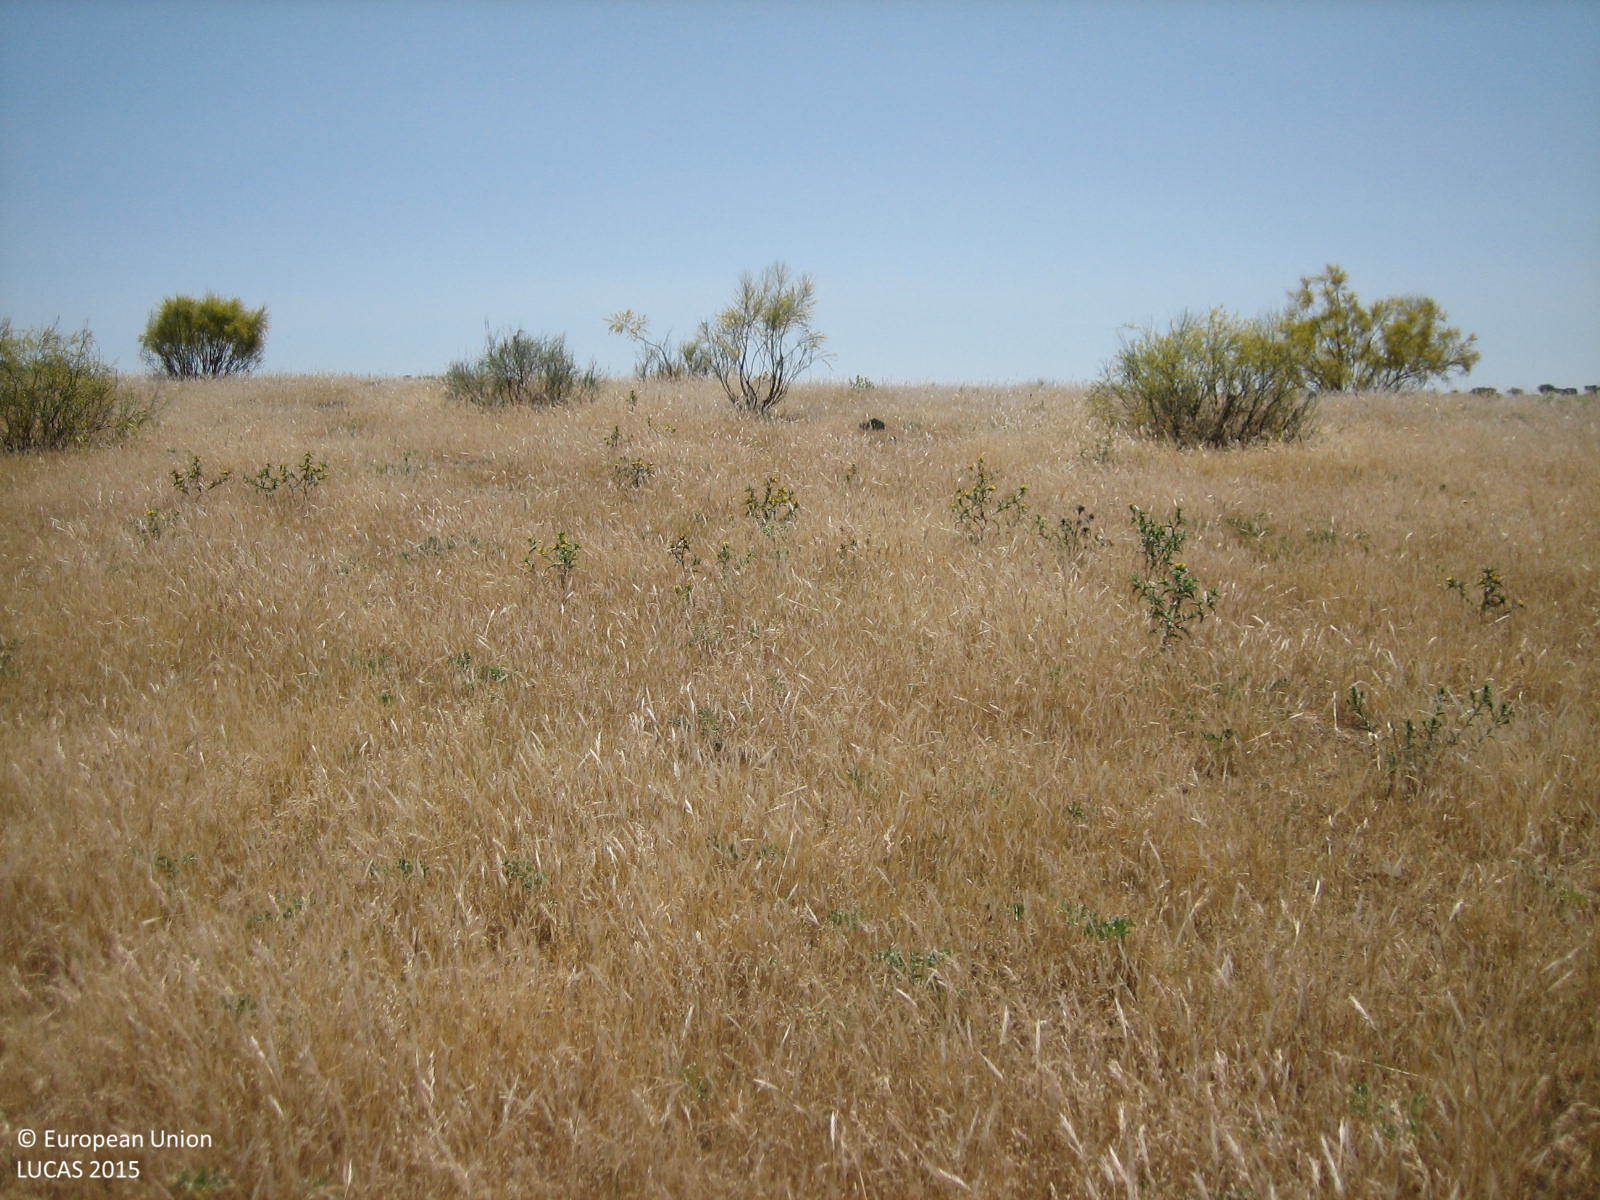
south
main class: Grassland
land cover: Grassland with sparse tree/shrub cover
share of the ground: > 75 %
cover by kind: herbaceous plants 90 %, broadleaved forest trees 5 %, shrubs 5 %
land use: Agriculture (excluding fallow land and kitchen gardens)
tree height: < 5 m
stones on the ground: < 10 %
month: May
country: ES
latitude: 38.9167
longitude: -5.1568
